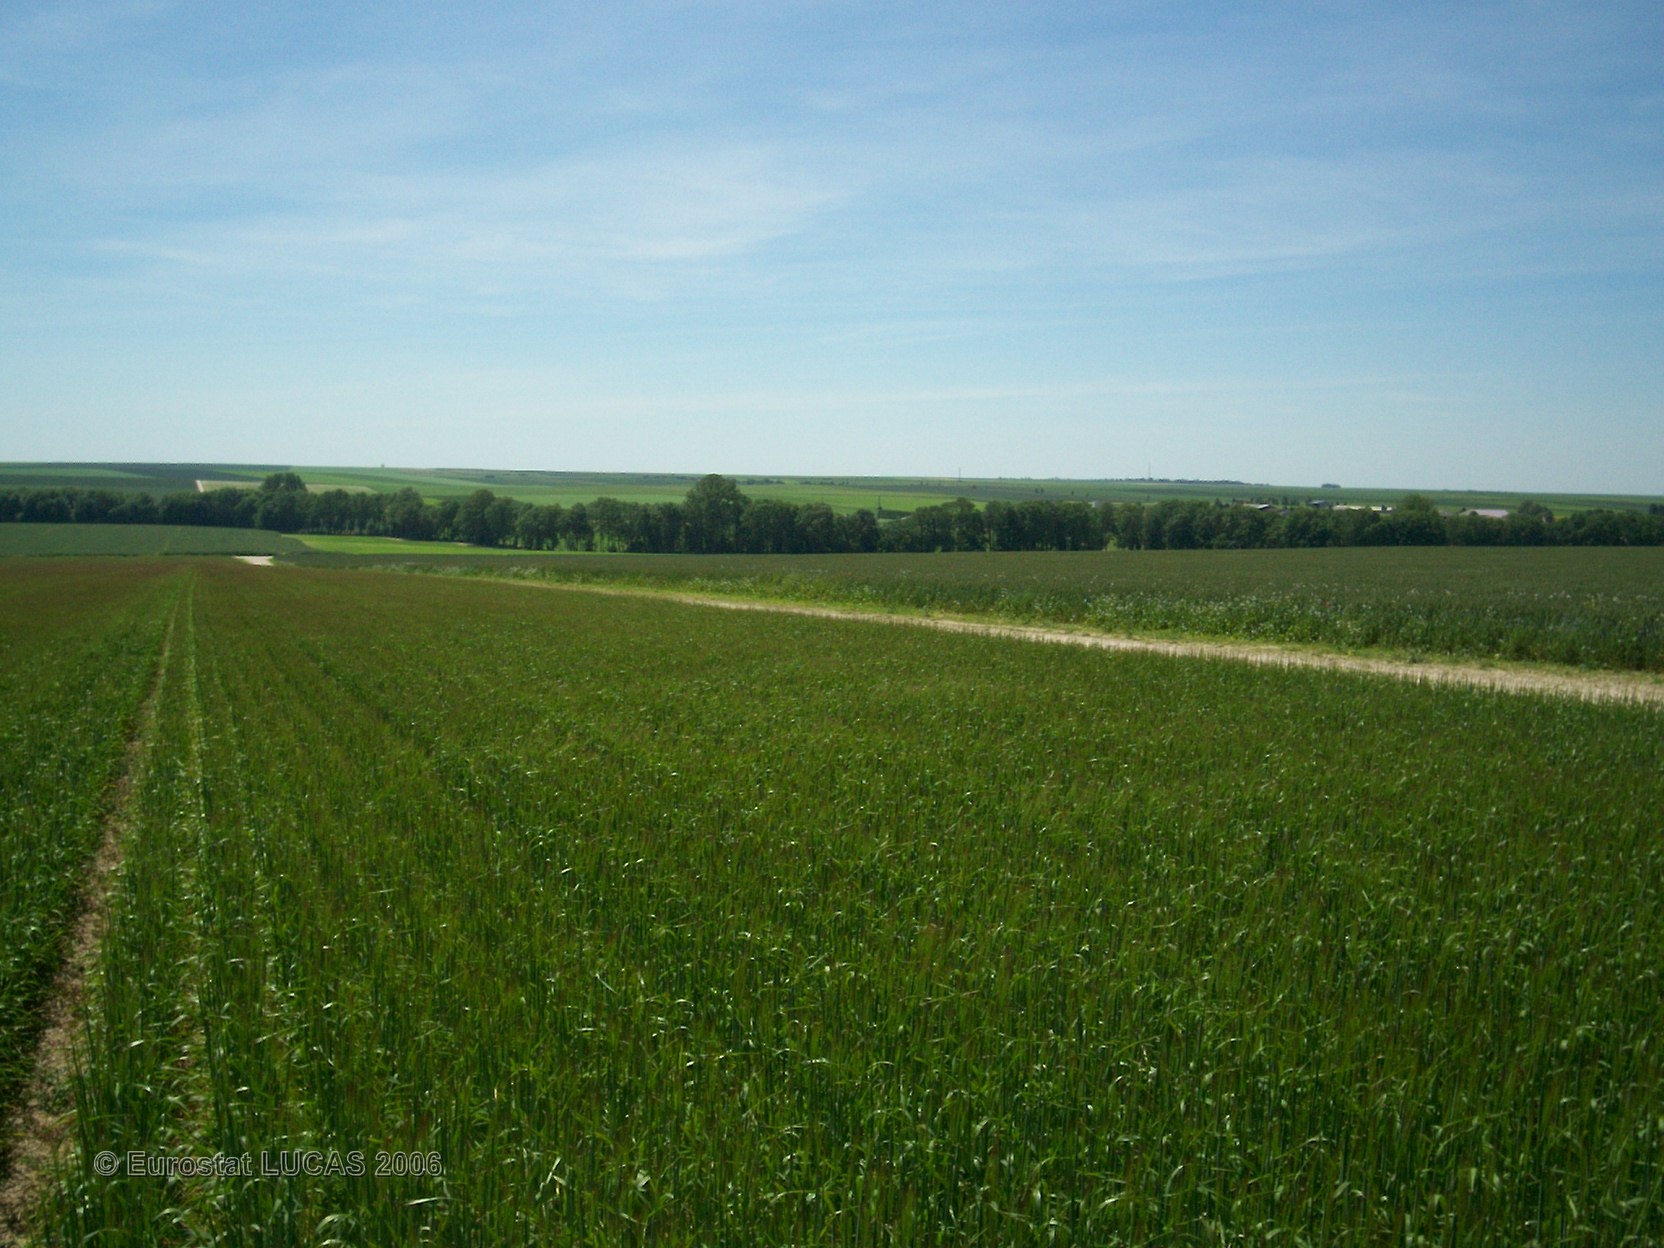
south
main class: Cropland
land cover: Barley
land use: Agriculture (excluding fallow land and kitchen gardens)
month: June
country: FR
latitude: 49.0645
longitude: 4.5906
